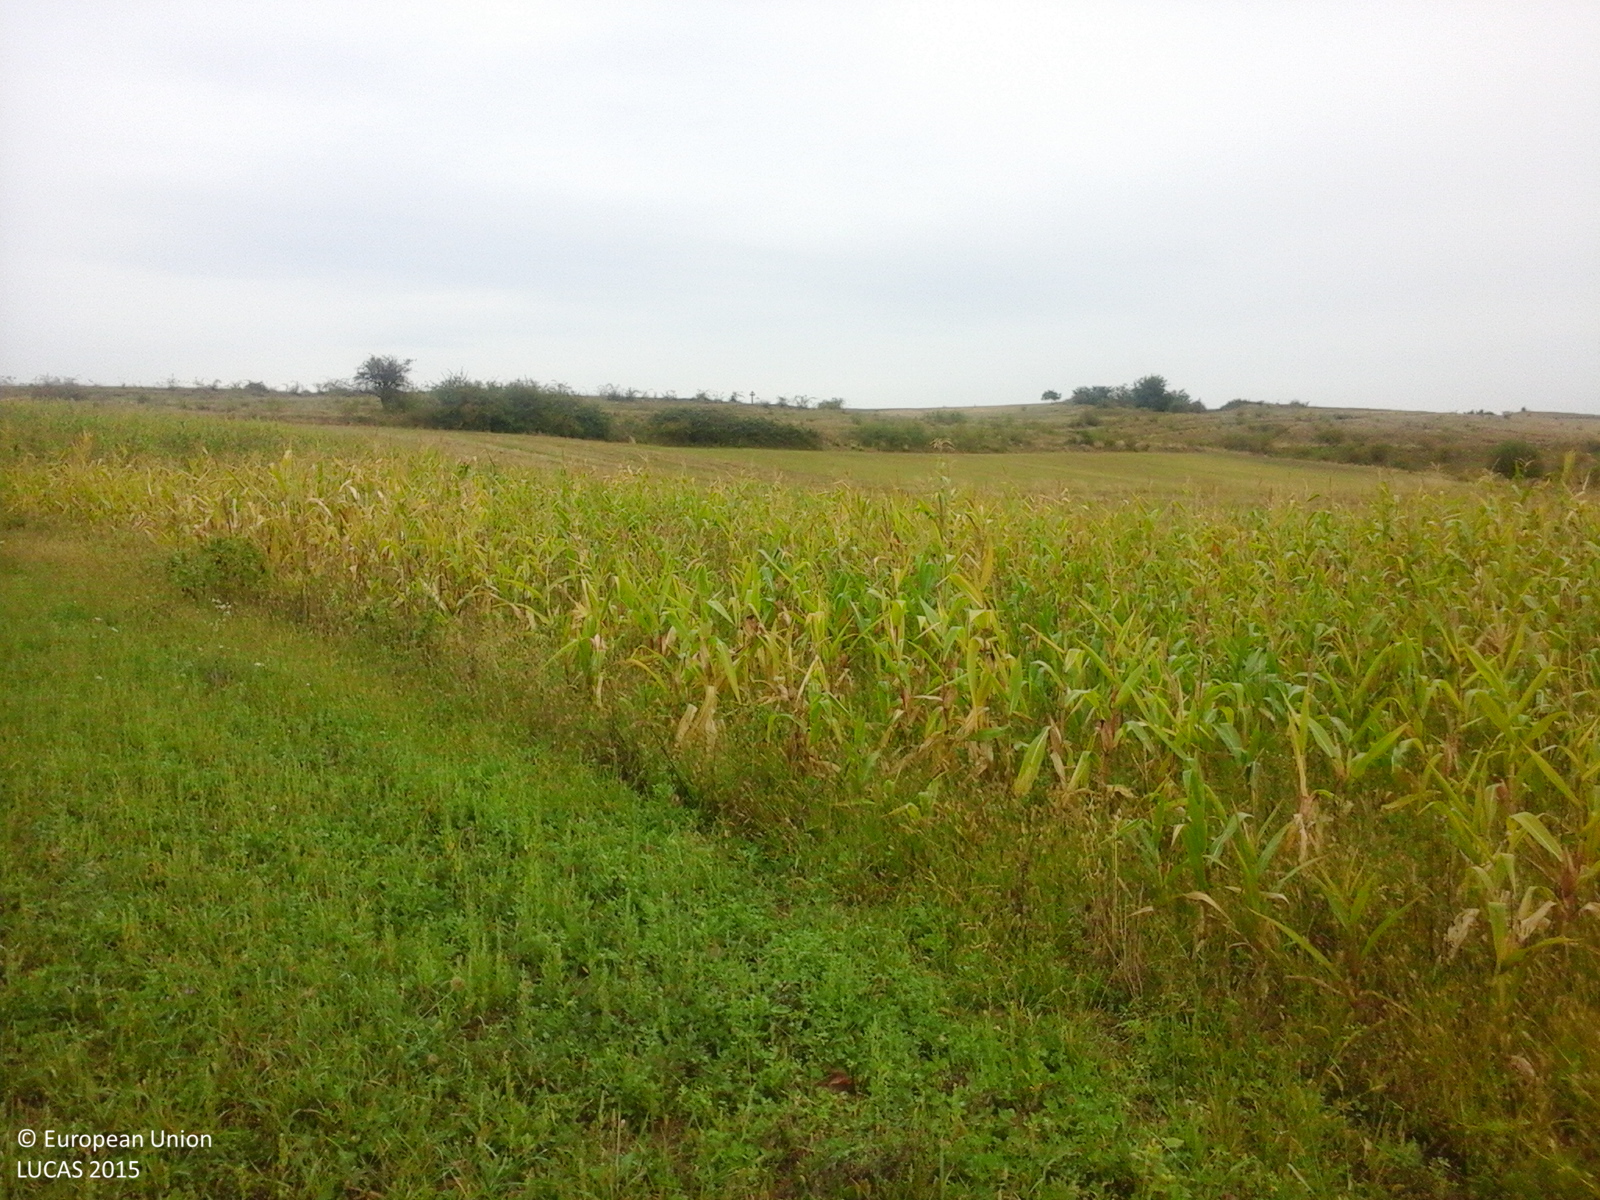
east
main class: Grassland
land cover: Grassland without tree/shrub cover
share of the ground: > 75 %
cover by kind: herbaceous plants 100 %
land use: Agriculture (excluding fallow land and kitchen gardens)
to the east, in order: Grassland without tree/shrub cover; Maize; Common wheat; Abandoned hedges; Grassland without tree/shrub cover; Tracks; Grassland with sparse tree/shrub cover; Grassland without tree/shrub cover
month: September
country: RO
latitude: 47.3906
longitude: 22.5768
